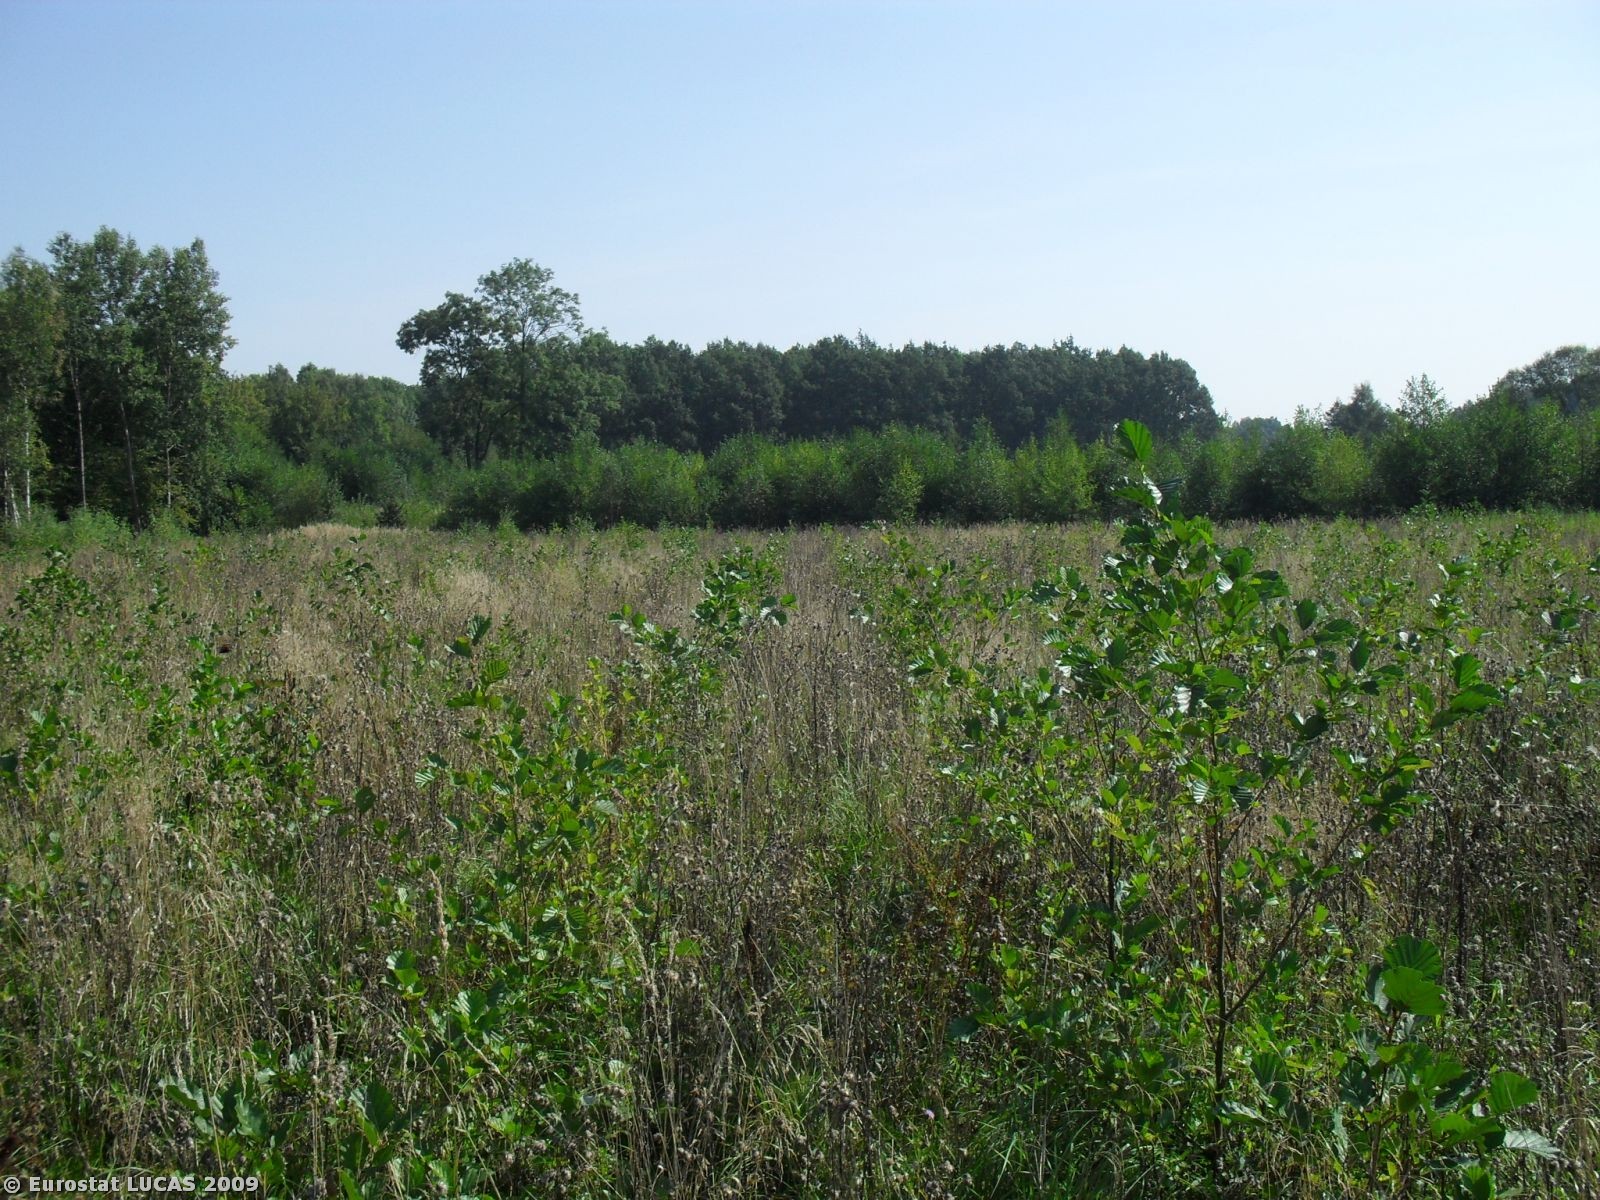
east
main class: Woodland
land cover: Broadleaved woodland
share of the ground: 25 - 50 %
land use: Forestry
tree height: < 5 m
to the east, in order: Broadleaved woodland; Ditches and canals; Broadleaved woodland; Shrubland with sparse tree cover; Grassland without tree/shrub cover; Bare land; Tracks; Grassland with sparse tree/shrub cover; Tracks; Broadleaved woodland
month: September
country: PL
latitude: 50.6027
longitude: 17.2596
